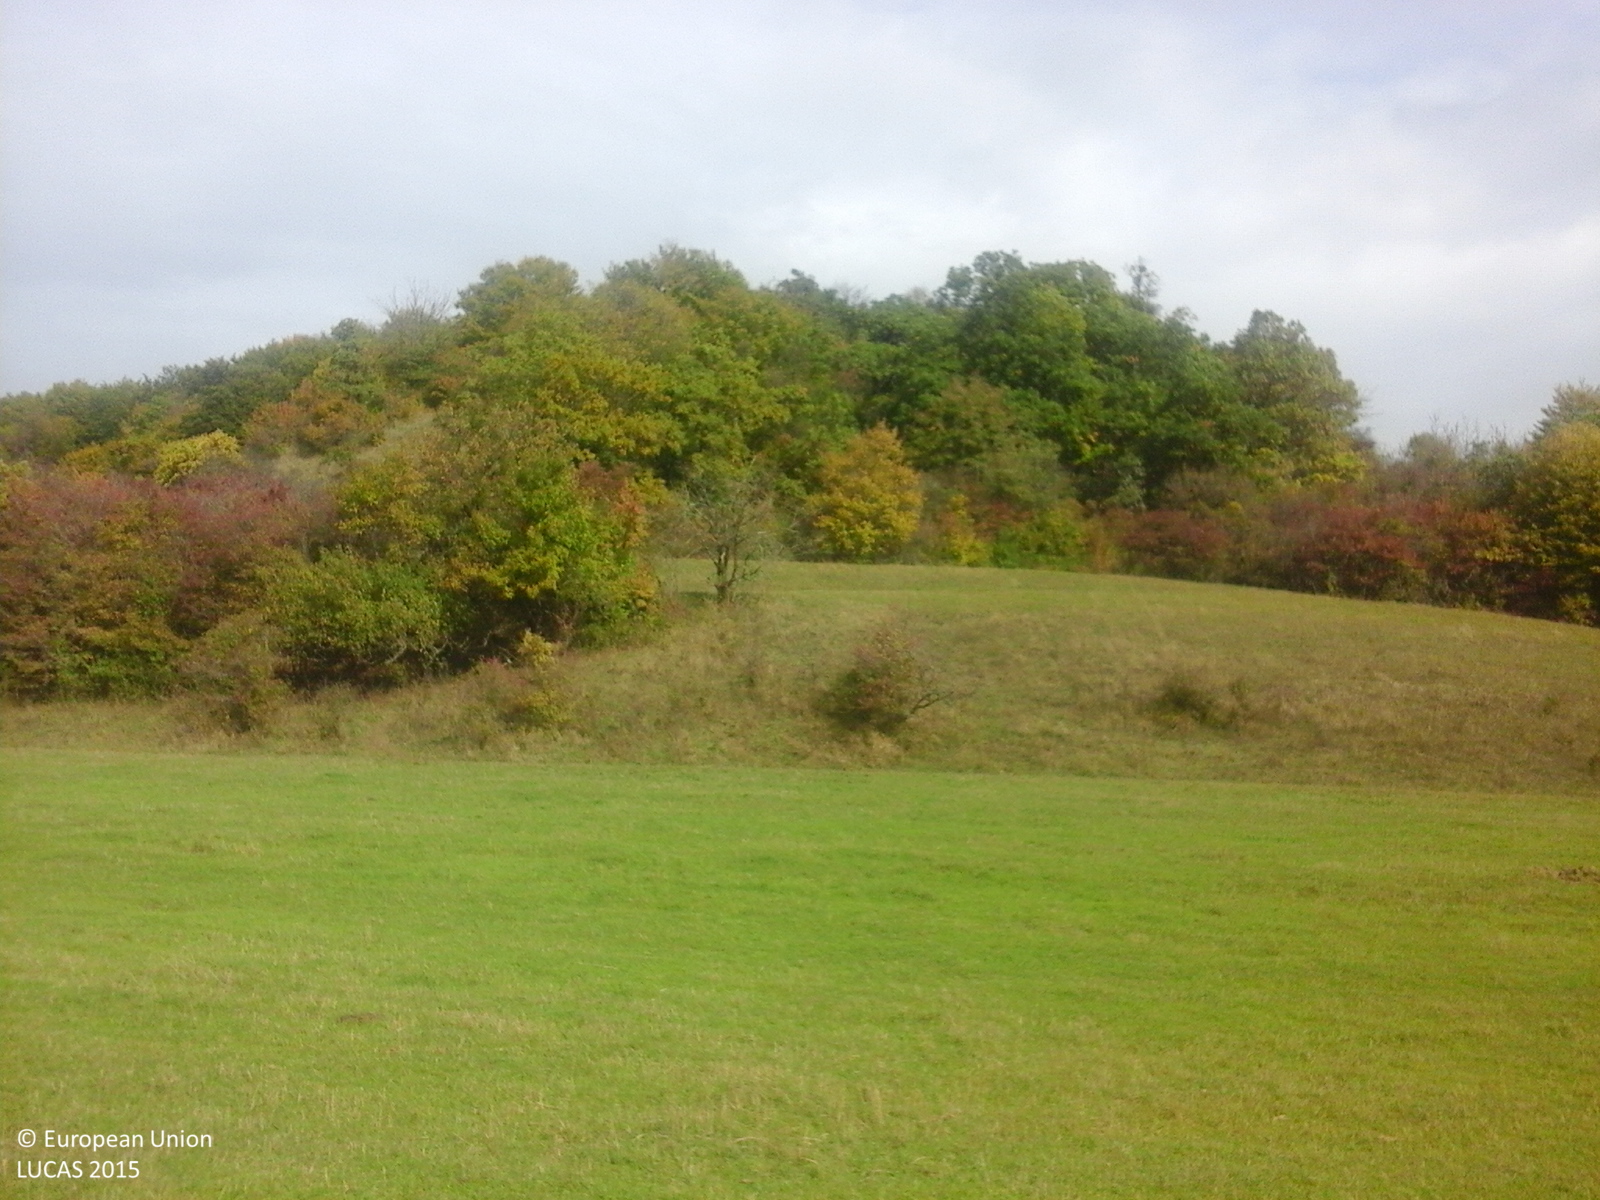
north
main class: Grassland
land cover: Grassland without tree/shrub cover
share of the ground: > 75 %
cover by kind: herbaceous plants 100 %
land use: Agriculture (excluding fallow land and kitchen gardens)
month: October
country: RO
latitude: 46.2130
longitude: 25.1743
